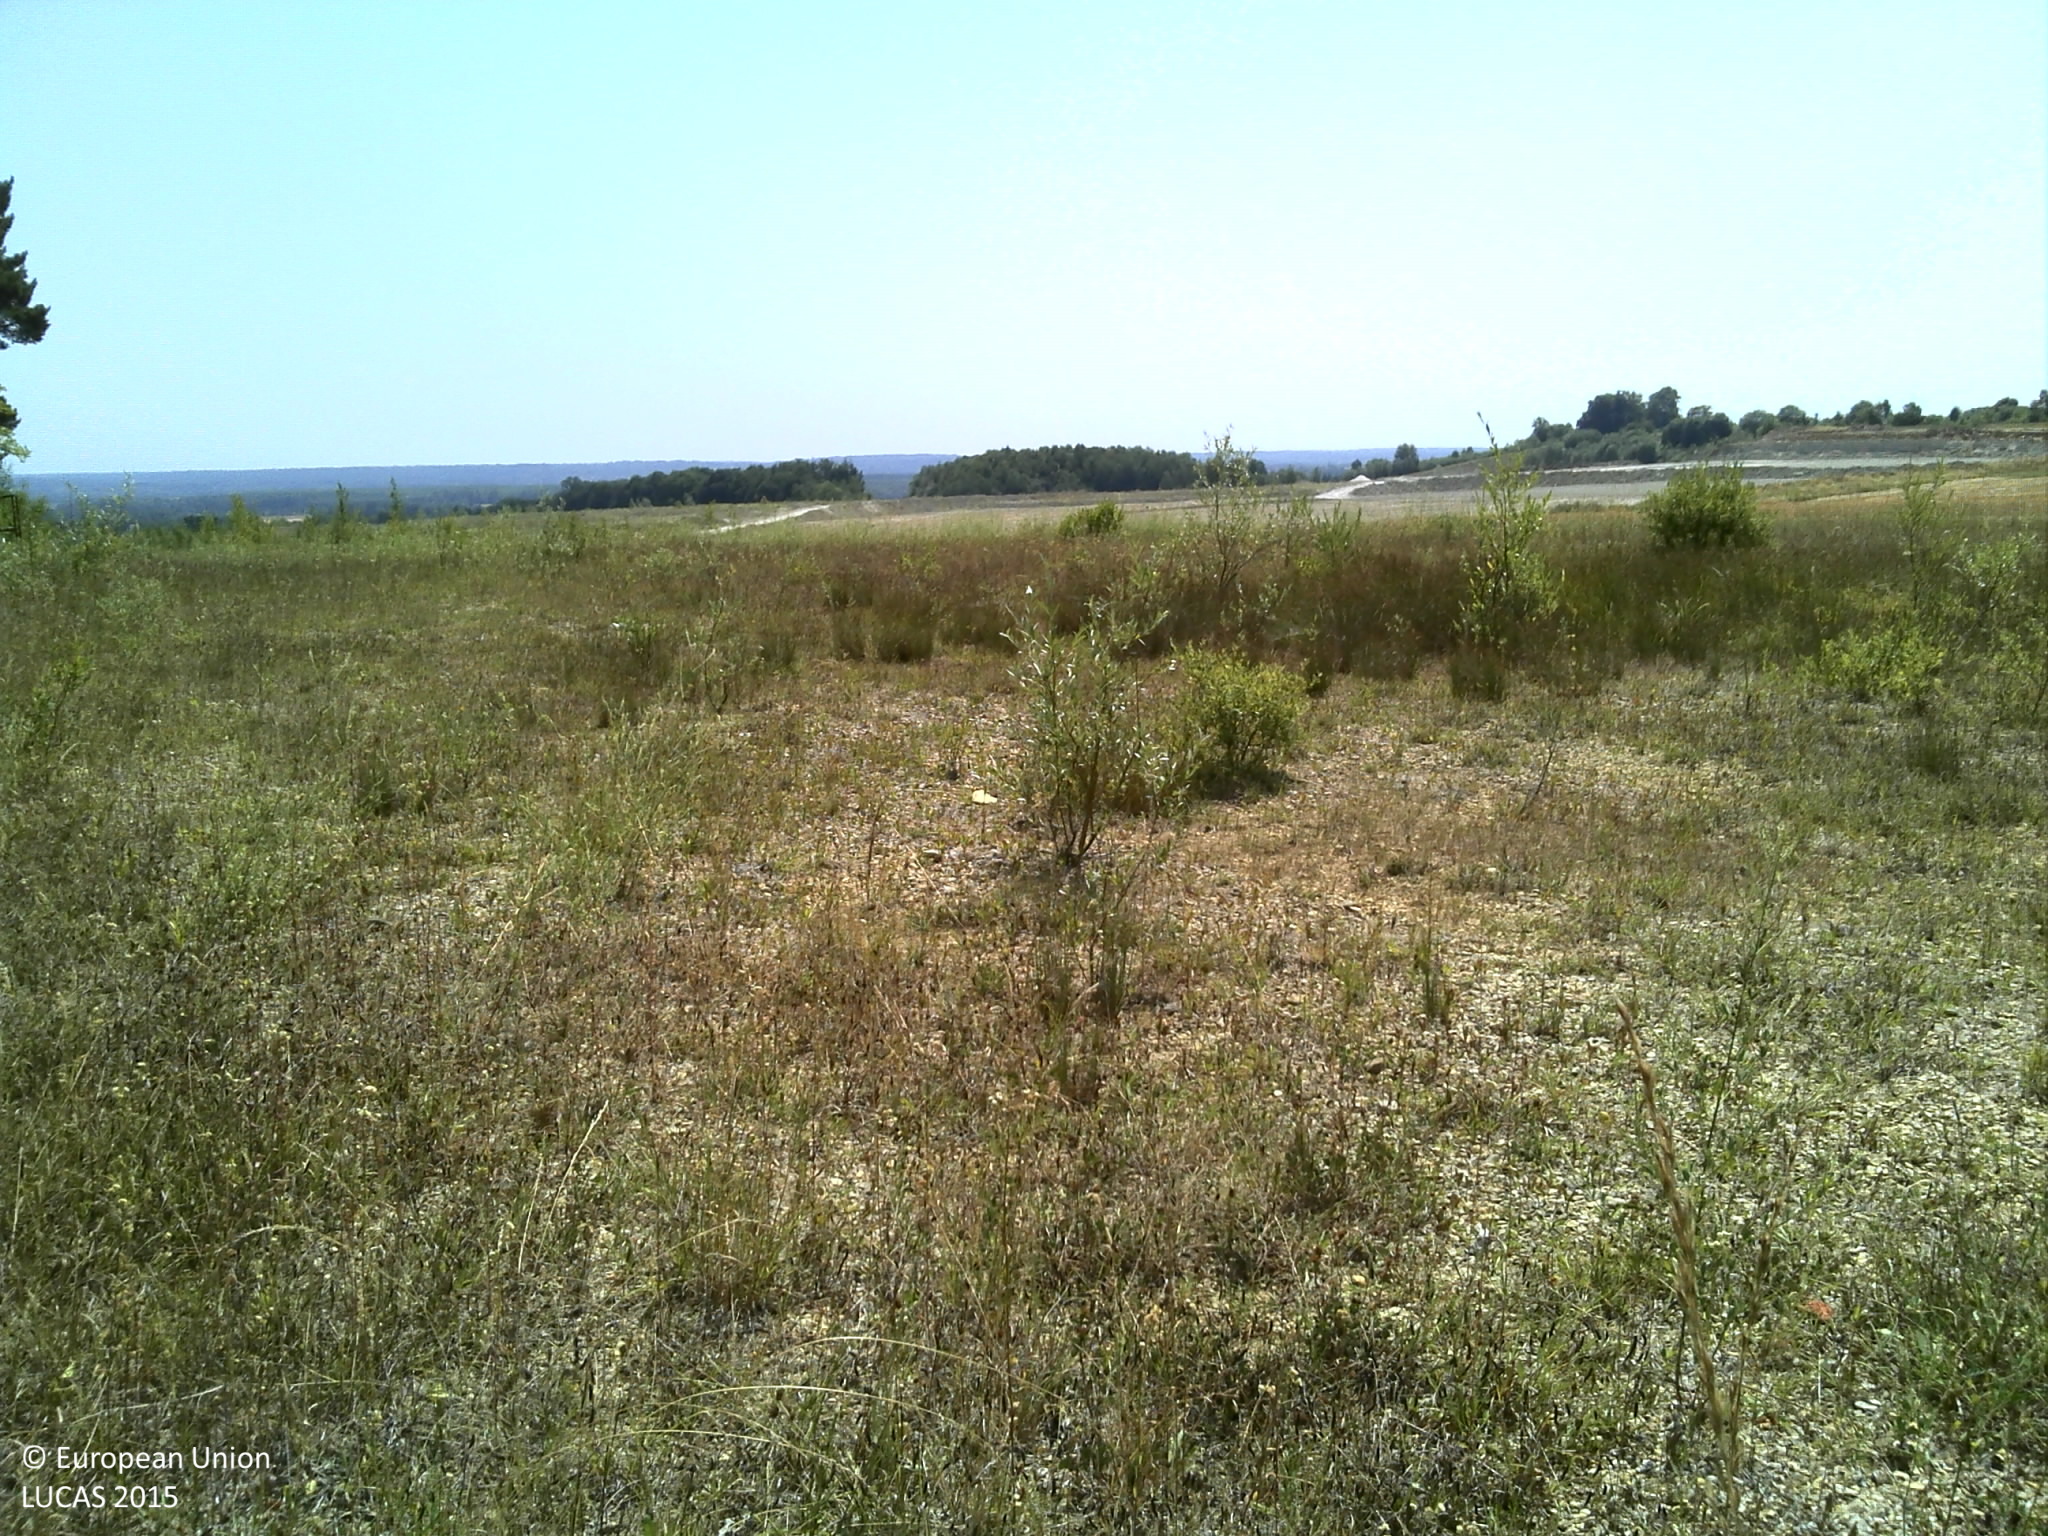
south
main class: Woodland
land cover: Broadleaved woodland
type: beech forest
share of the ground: > 75 %
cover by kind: broadleaved forest trees 85 %, coniferous forest trees 10 %, herbaceous plants 5 %
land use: Forestry
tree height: > 5 m
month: July
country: FR
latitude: 48.8441
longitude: 4.8879
